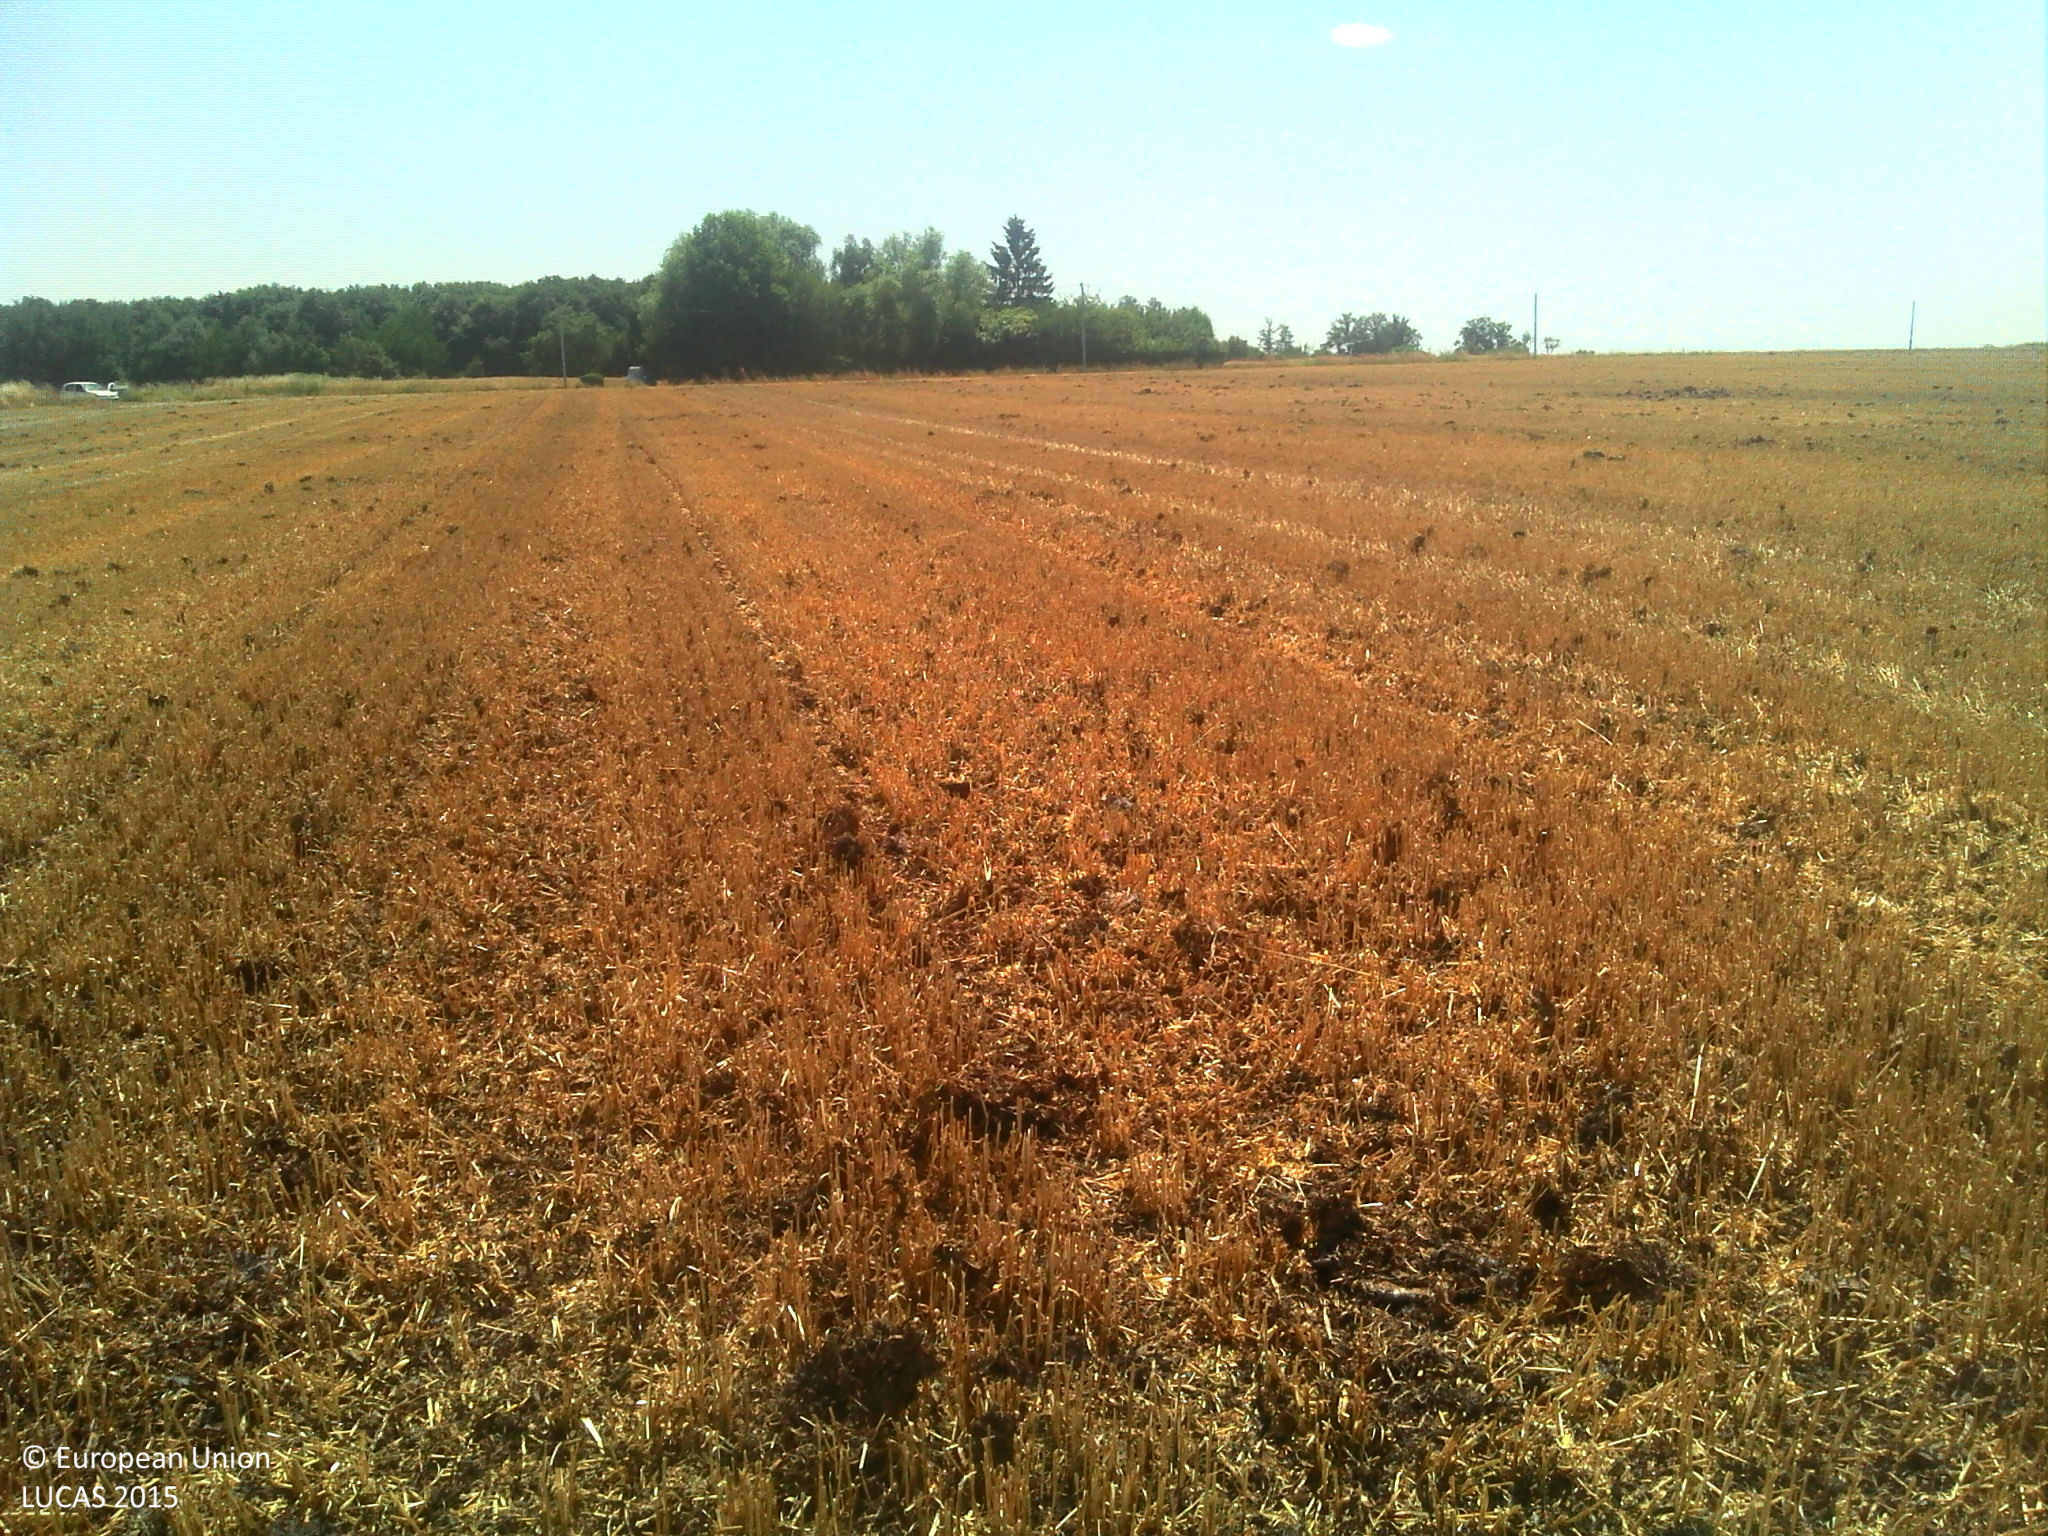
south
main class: Cropland
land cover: Durum wheat
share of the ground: > 75 %
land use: Agriculture (excluding fallow land and kitchen gardens)
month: July
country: FR
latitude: 48.0991
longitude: 0.8887
